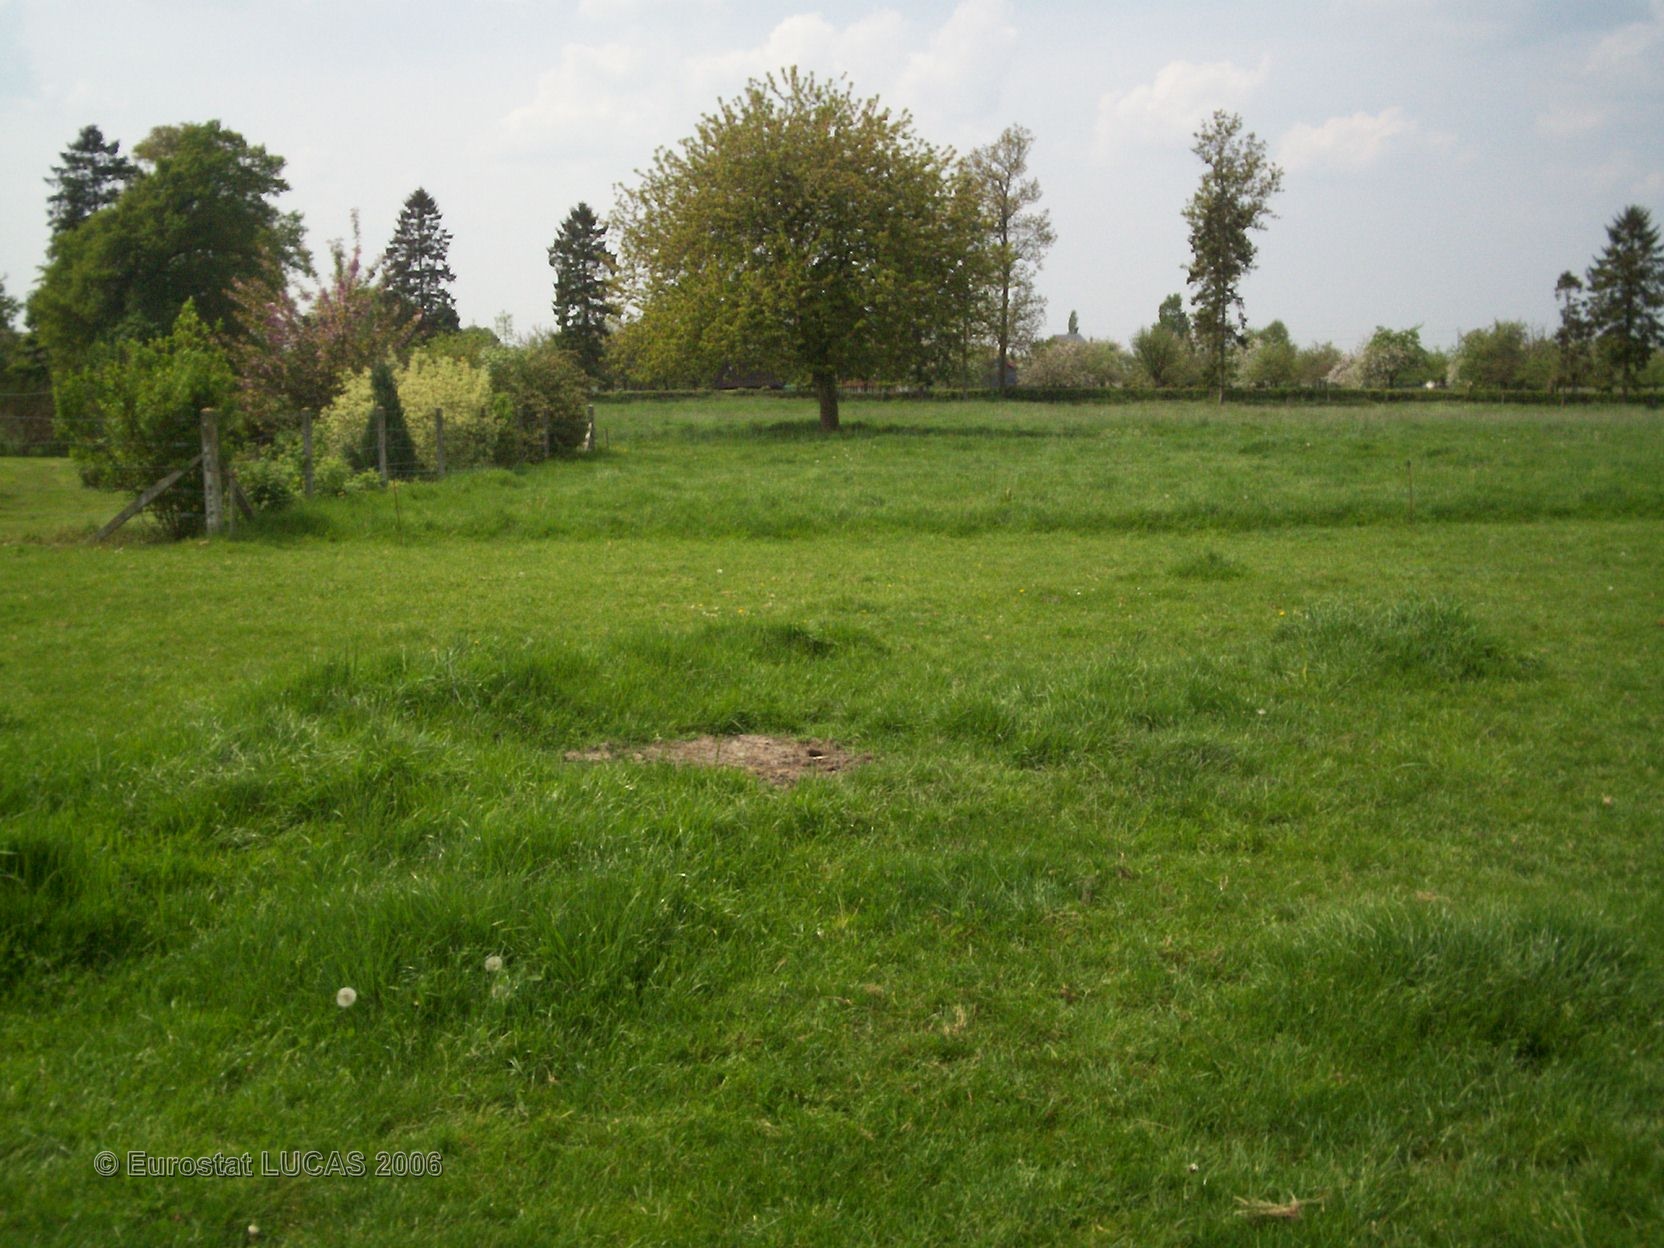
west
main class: Grassland
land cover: Grassland without tree/shrub cover
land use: Agriculture (excluding fallow land and kitchen gardens)
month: May
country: FR
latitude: 49.2822
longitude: 0.5298
